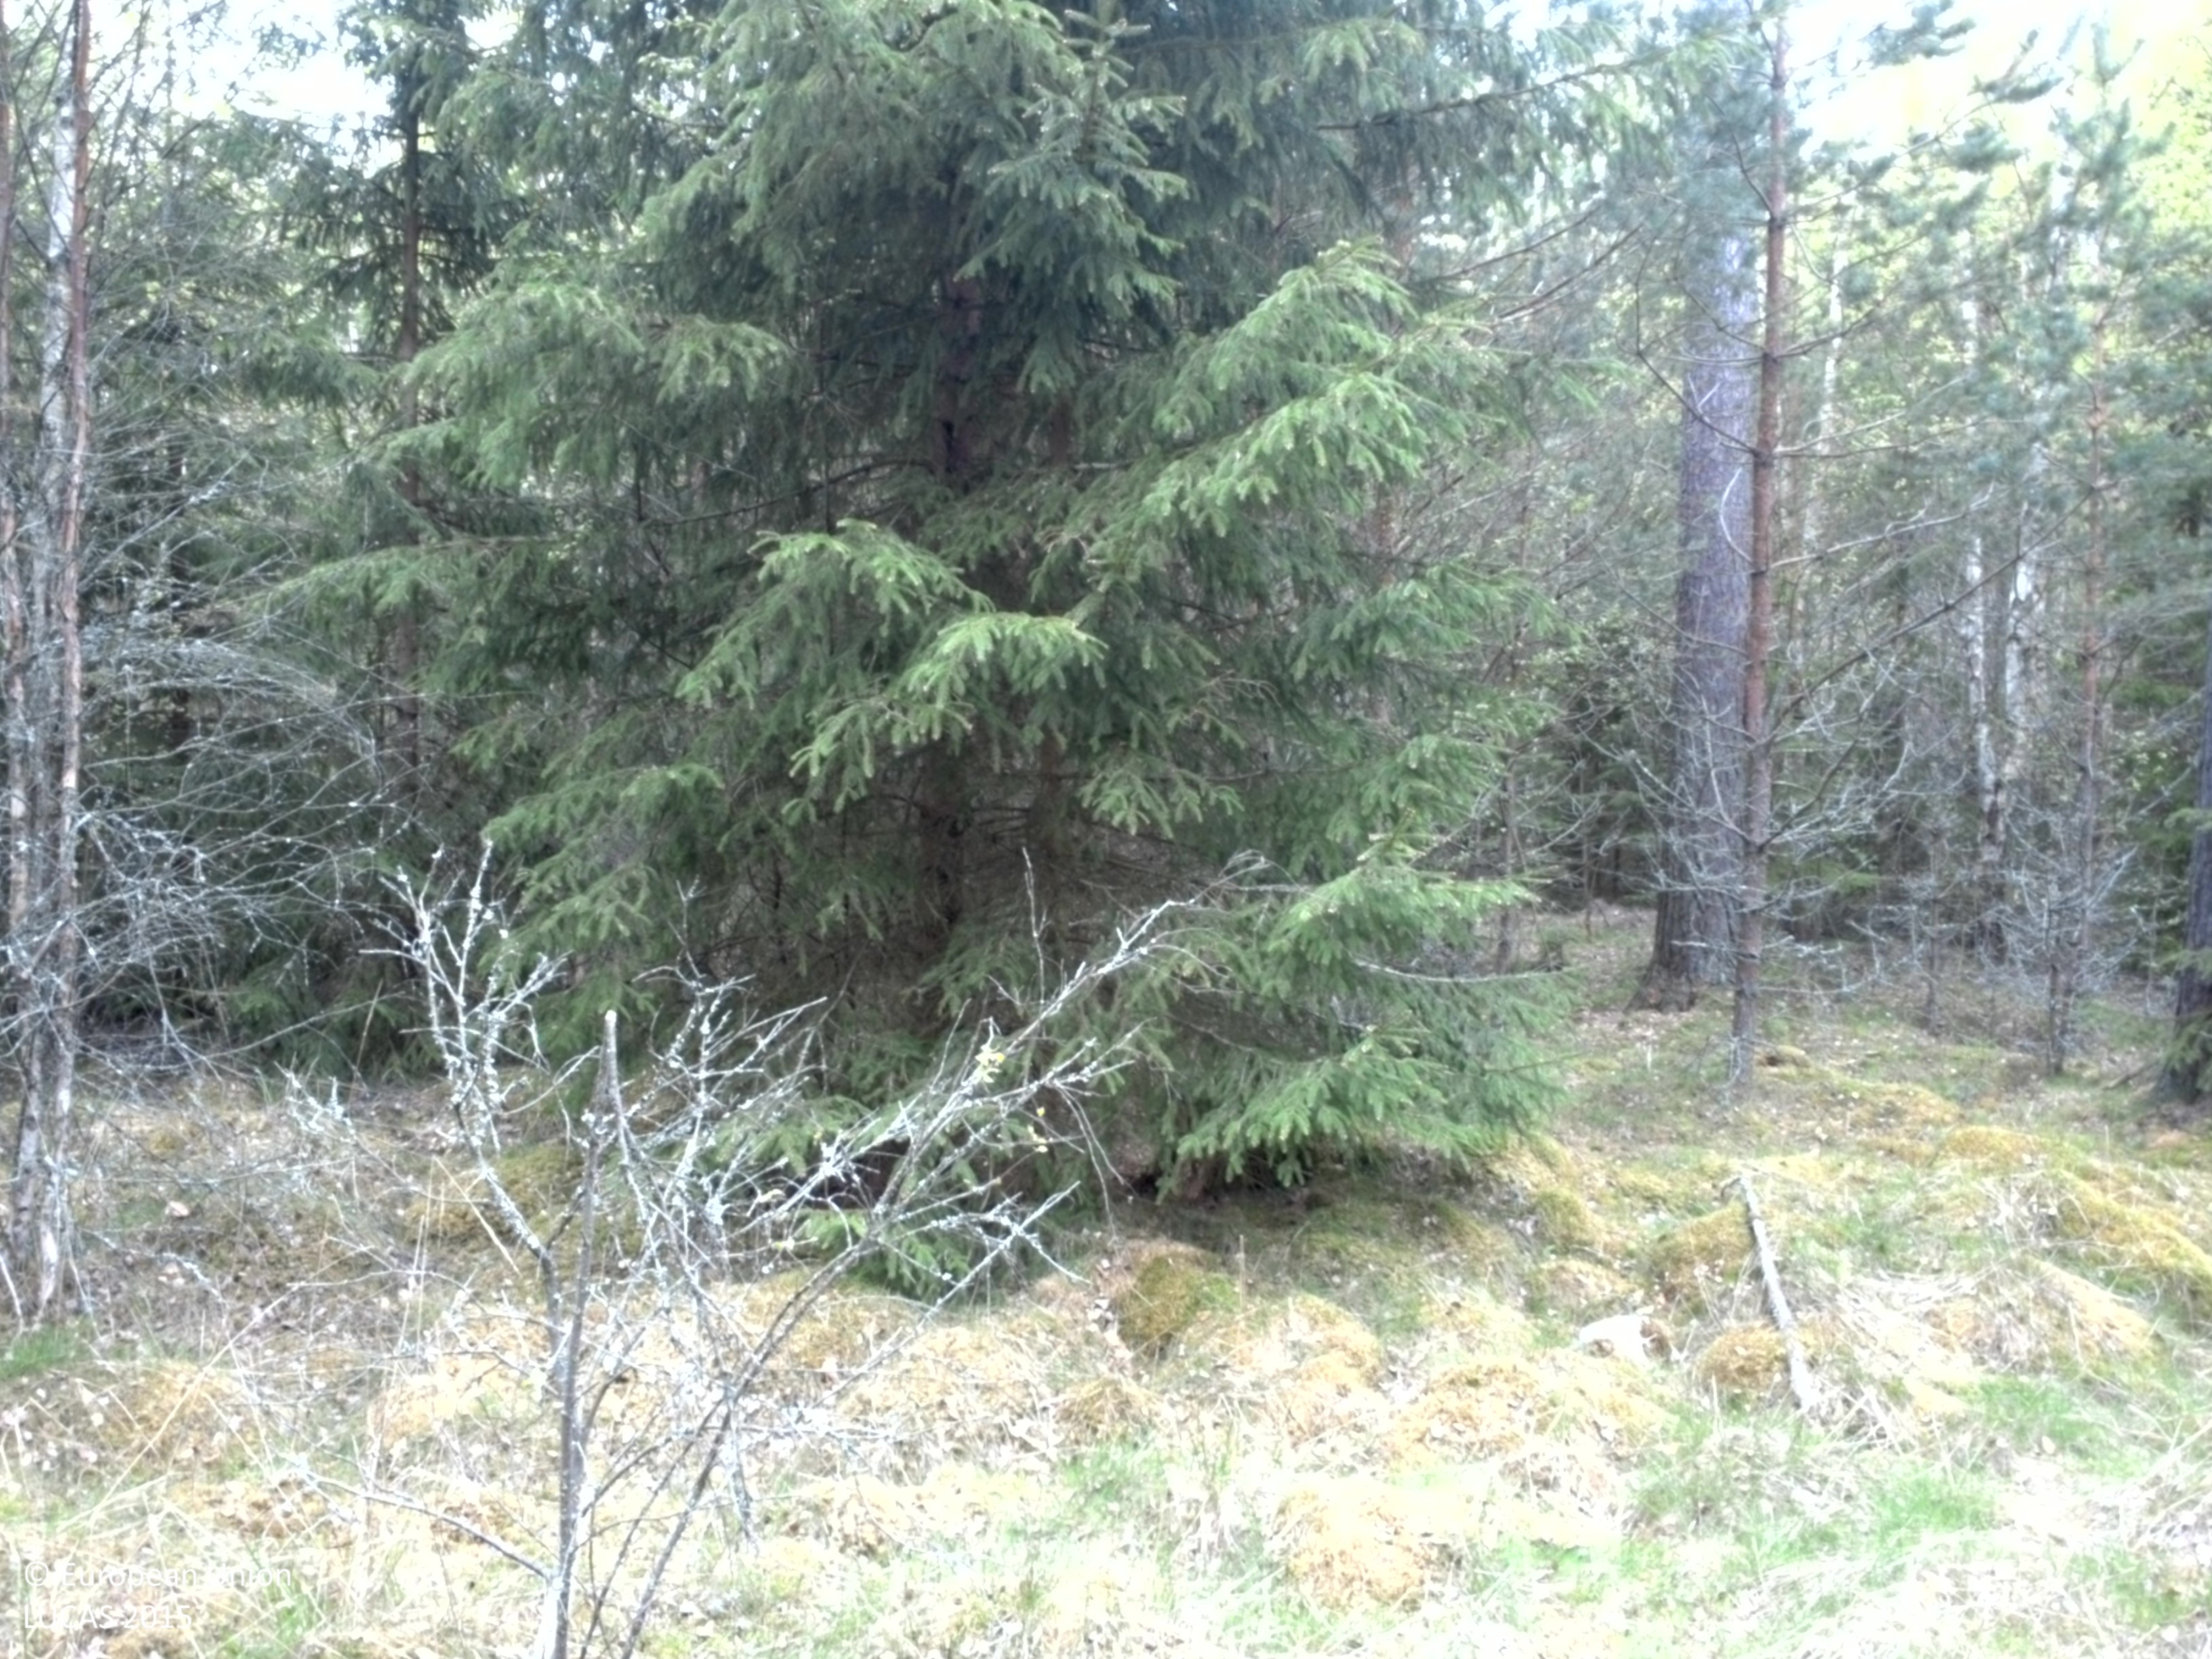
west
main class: Woodland
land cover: Pine dominated mixed woodland
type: boreal forest
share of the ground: > 75 %
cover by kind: coniferous forest trees 60 %, broadleaved forest trees 20 %, shrubs 10 %, herbaceous plants 10 %
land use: Forestry
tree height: > 5 m
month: May
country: SE
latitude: 59.2566
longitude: 14.0782
